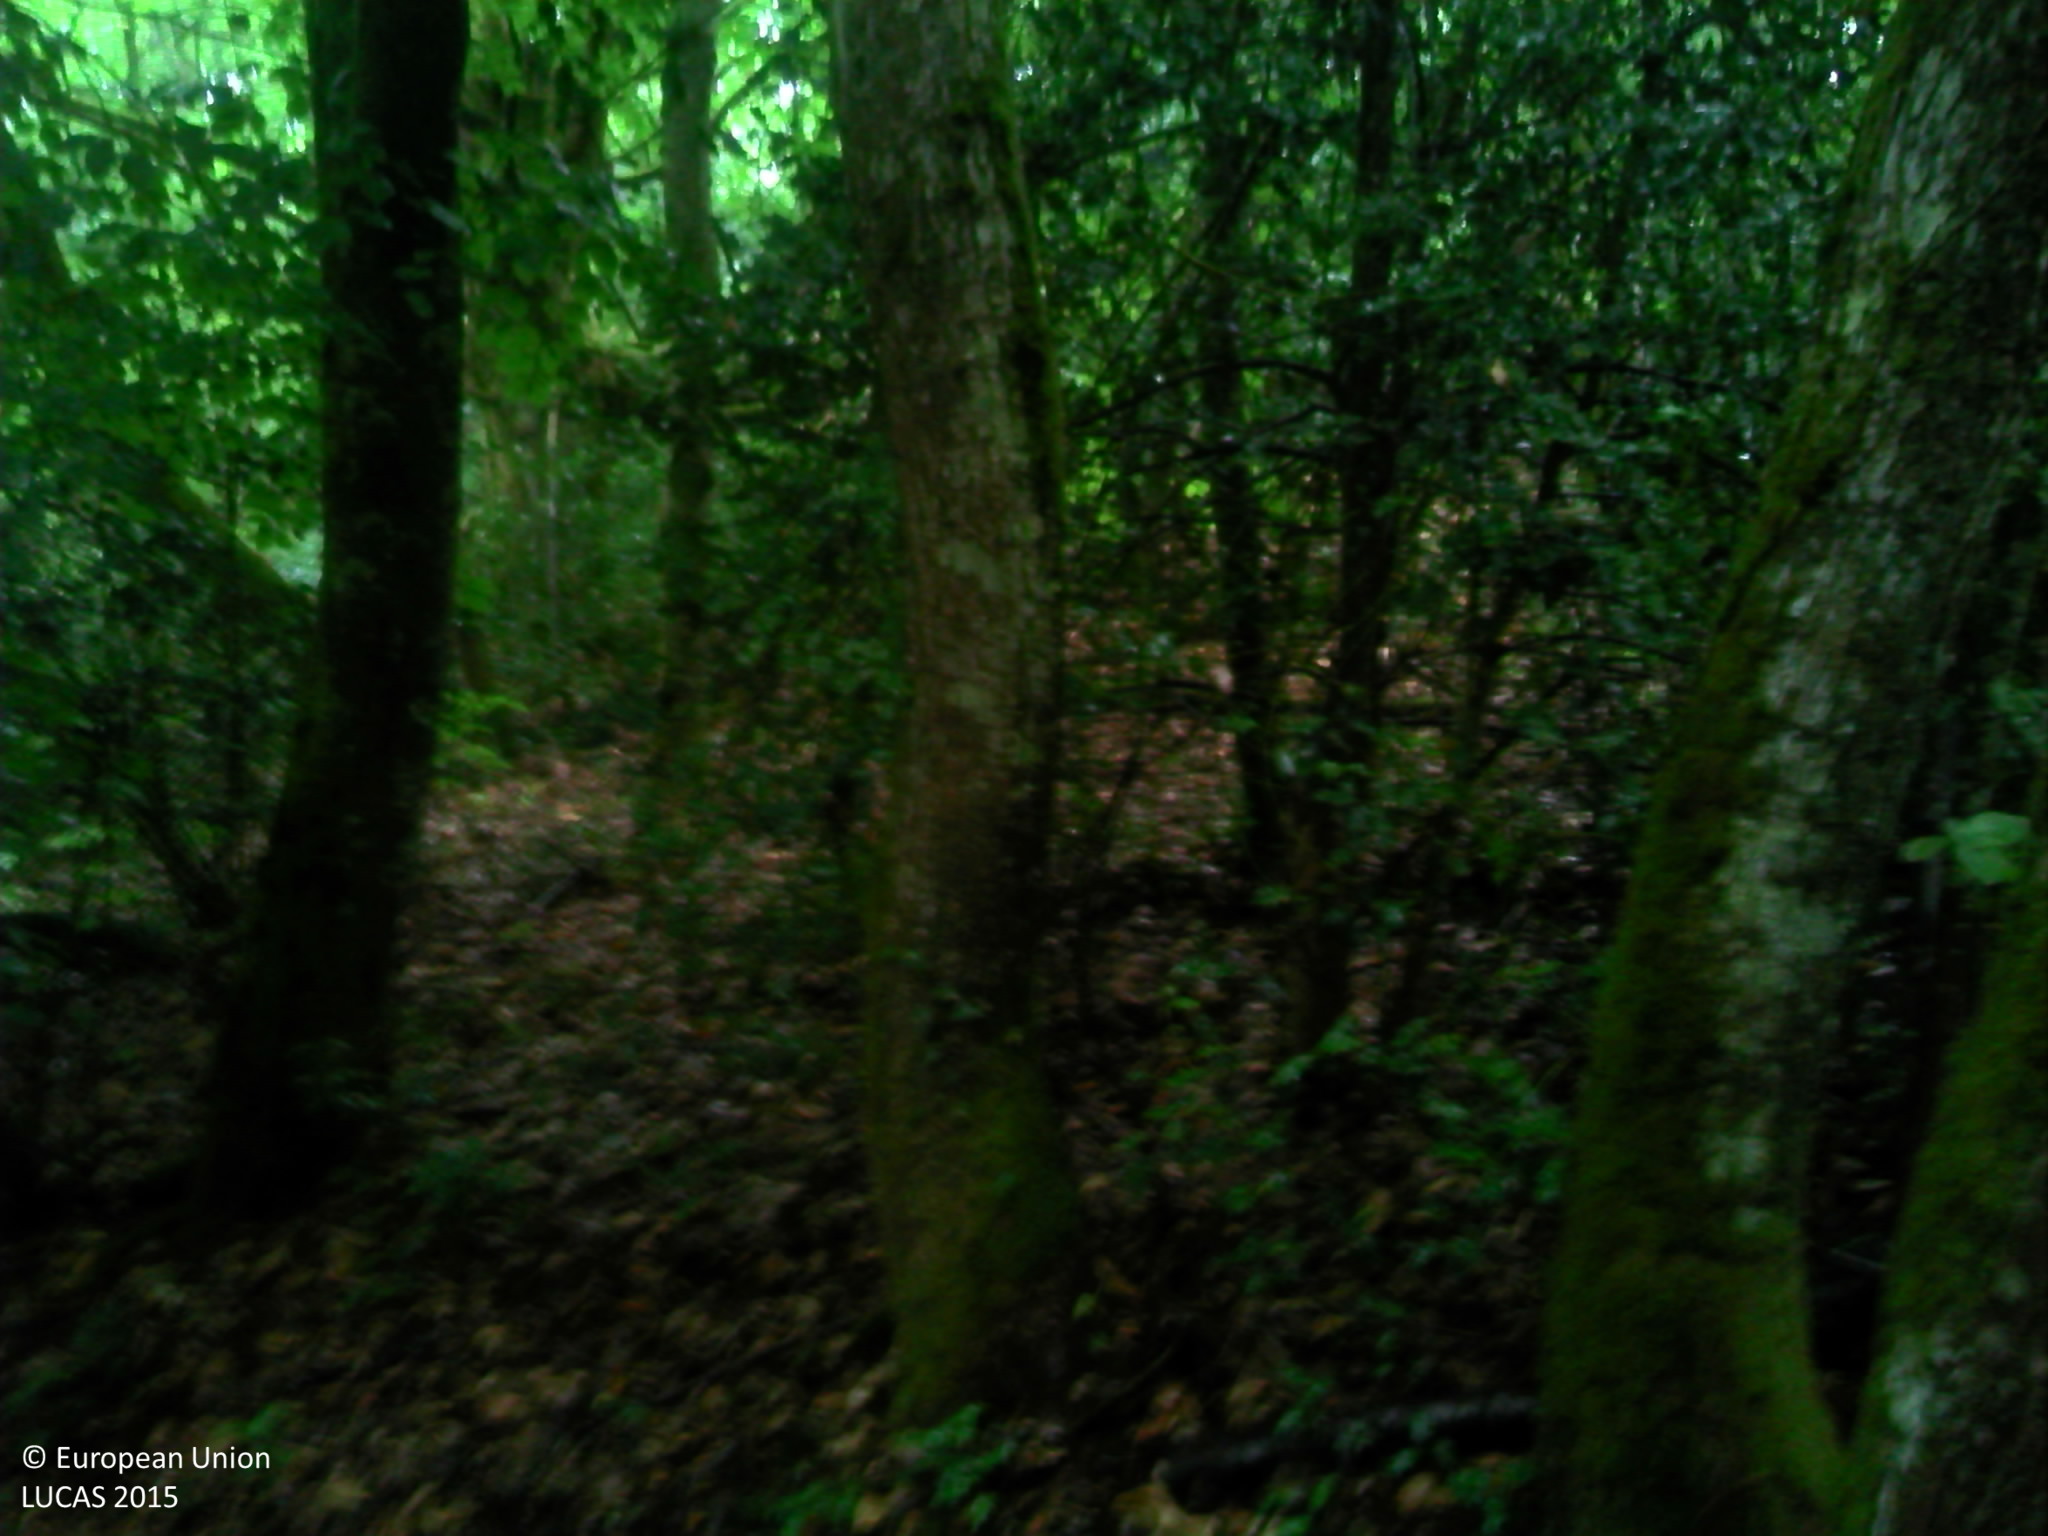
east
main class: Woodland
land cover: Broadleaved woodland
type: thermophilous deciduous forest
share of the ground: > 75 %
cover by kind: broadleaved forest trees 65 %, shrubs 15 %, herbaceous plants 15 %, lichens and mosses 5 %
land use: Forestry
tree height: > 5 m
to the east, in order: Broadleaved woodland; Dry stone walls; Broadleaved woodland; Rock outcrops; Broadleaved woodland; Dry stone walls; Broadleaved woodland; Dry stone walls; Broadleaved woodland; Dry stone walls; Broadleaved woodland; Dry stone walls; Broadleaved woodland; Dry stone walls; Shrubland without tree cover; Dry stone walls; Broadleaved woodland; Dry stone walls; Tracks
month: August
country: FR
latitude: 46.3224
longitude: 2.2406
